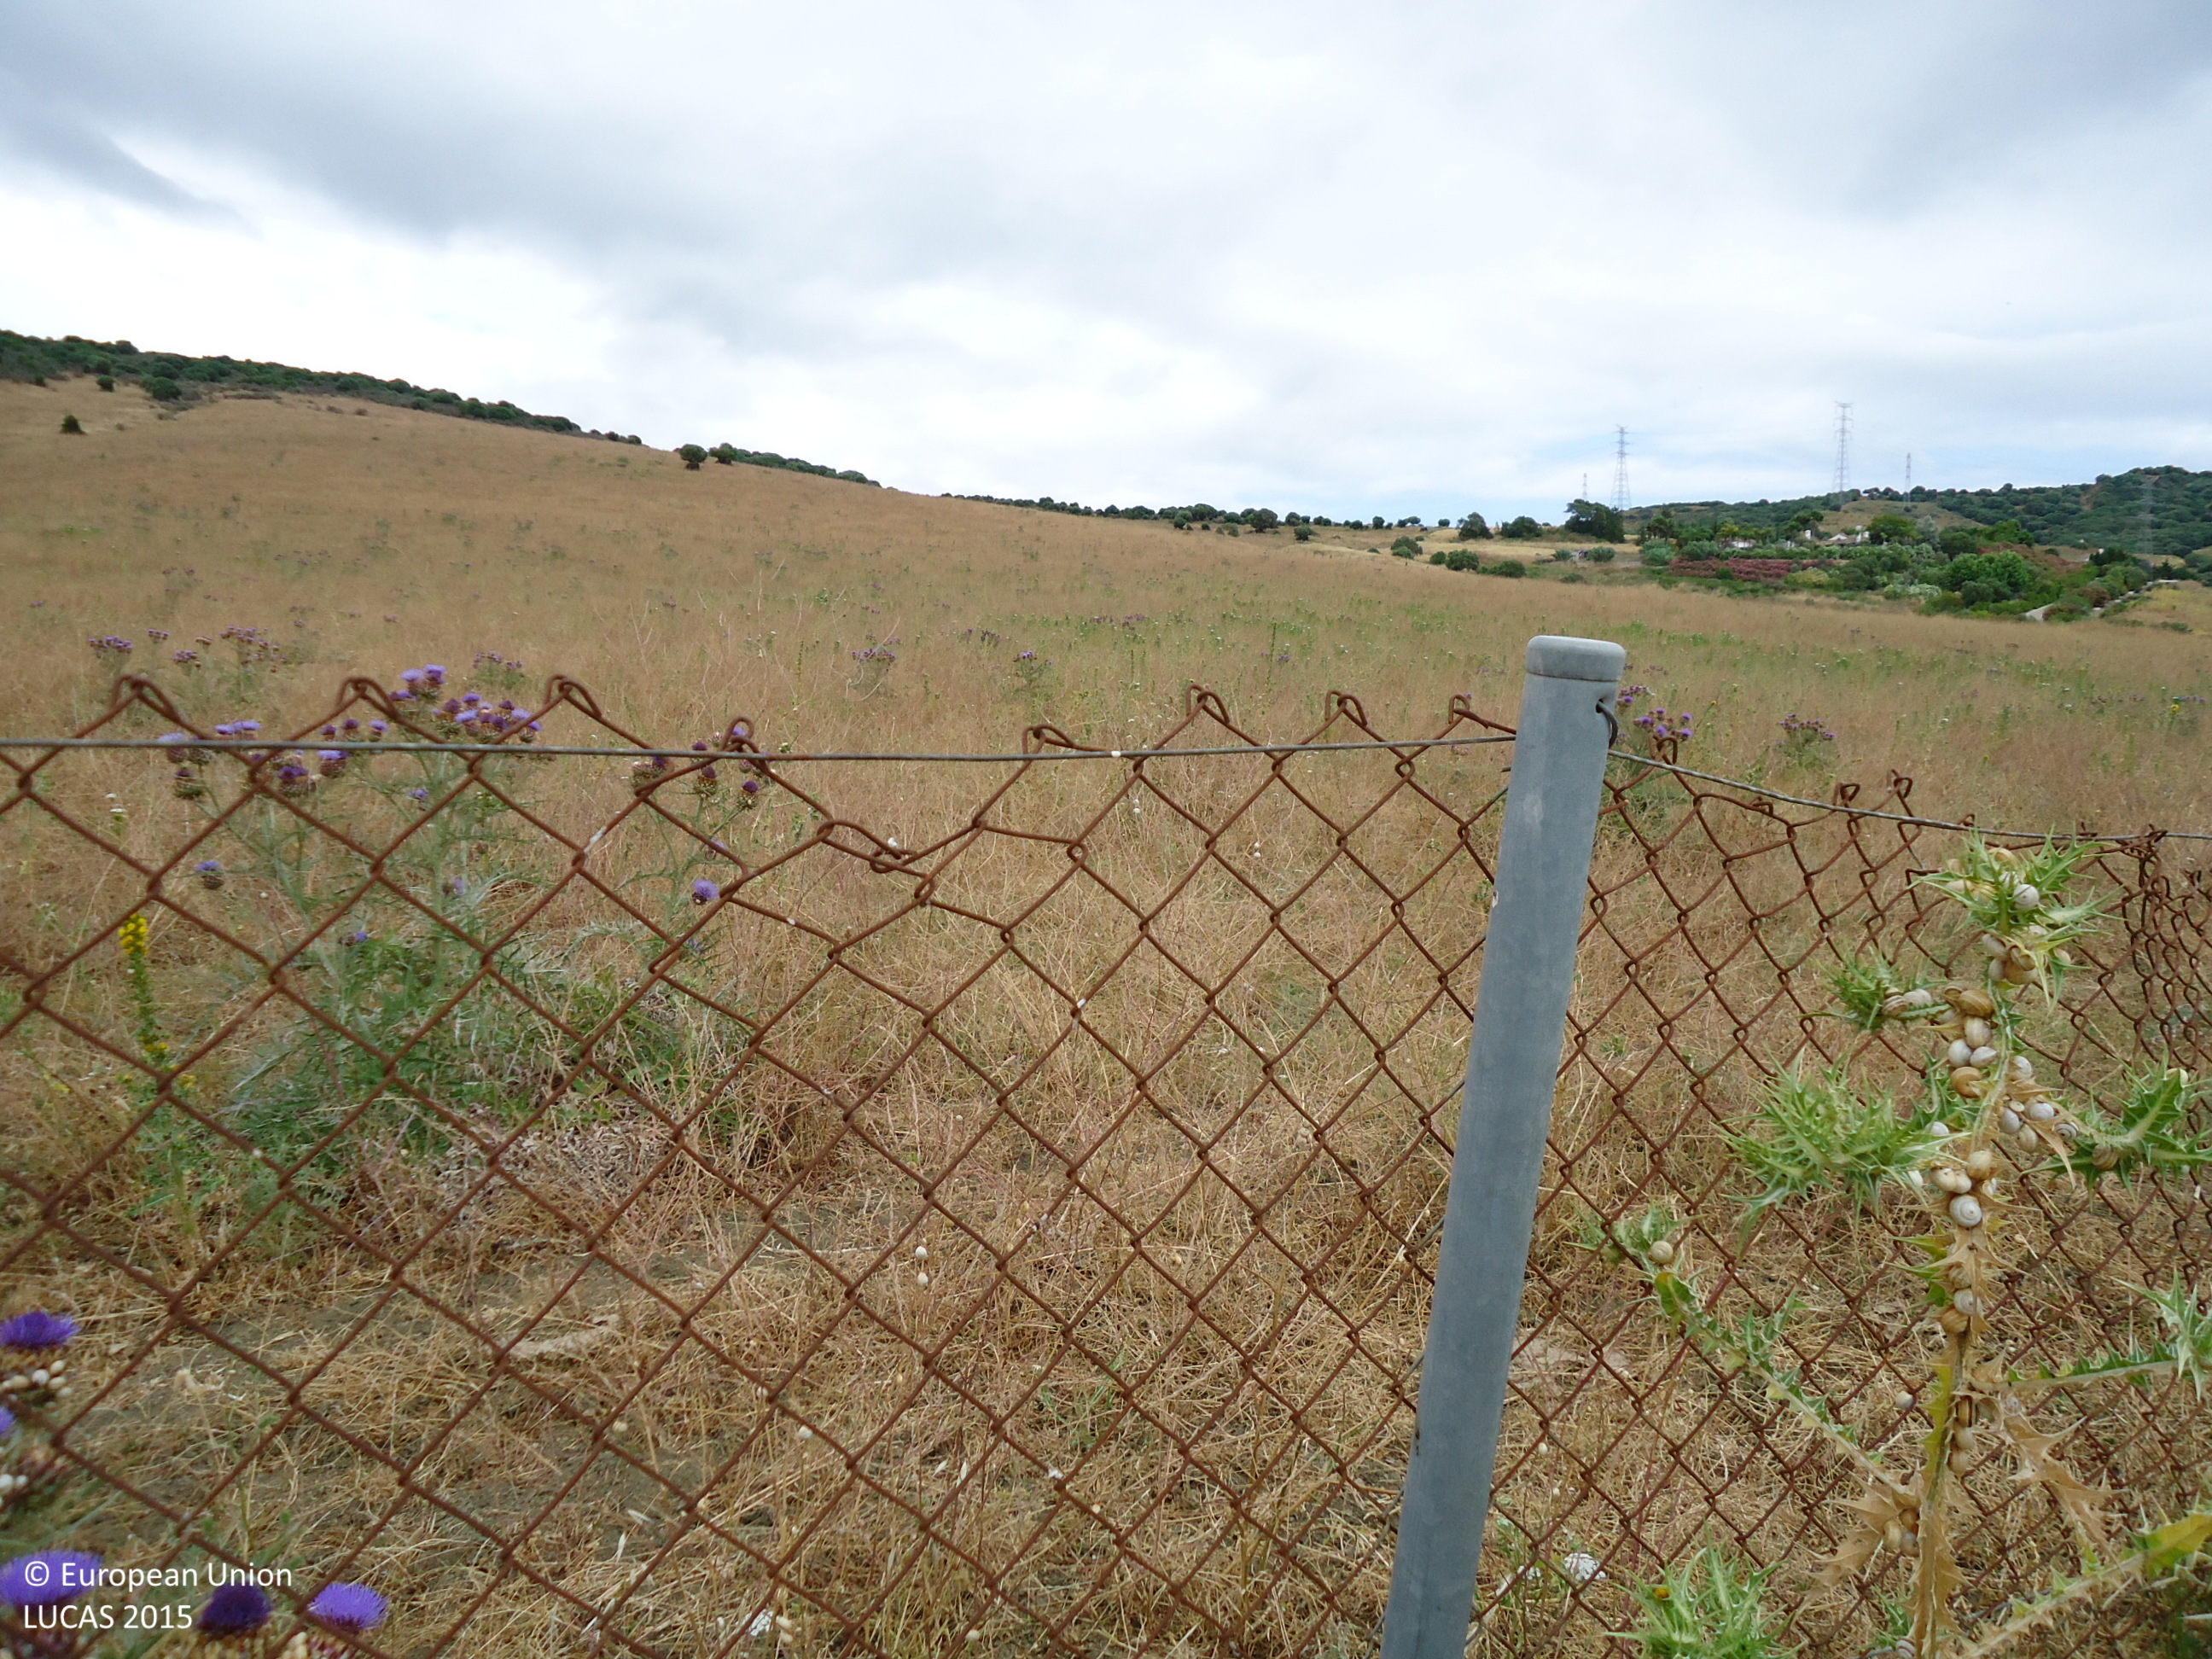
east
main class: Grassland
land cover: Spontaneously vegetated surfaces
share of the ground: > 75 %
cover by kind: herbaceous plants 100 %
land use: Agriculture (excluding fallow land and kitchen gardens)
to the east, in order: Spontaneously vegetated surfaces; Fences; Spontaneously vegetated surfaces
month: June
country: ES
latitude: 36.3443
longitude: -5.3591
